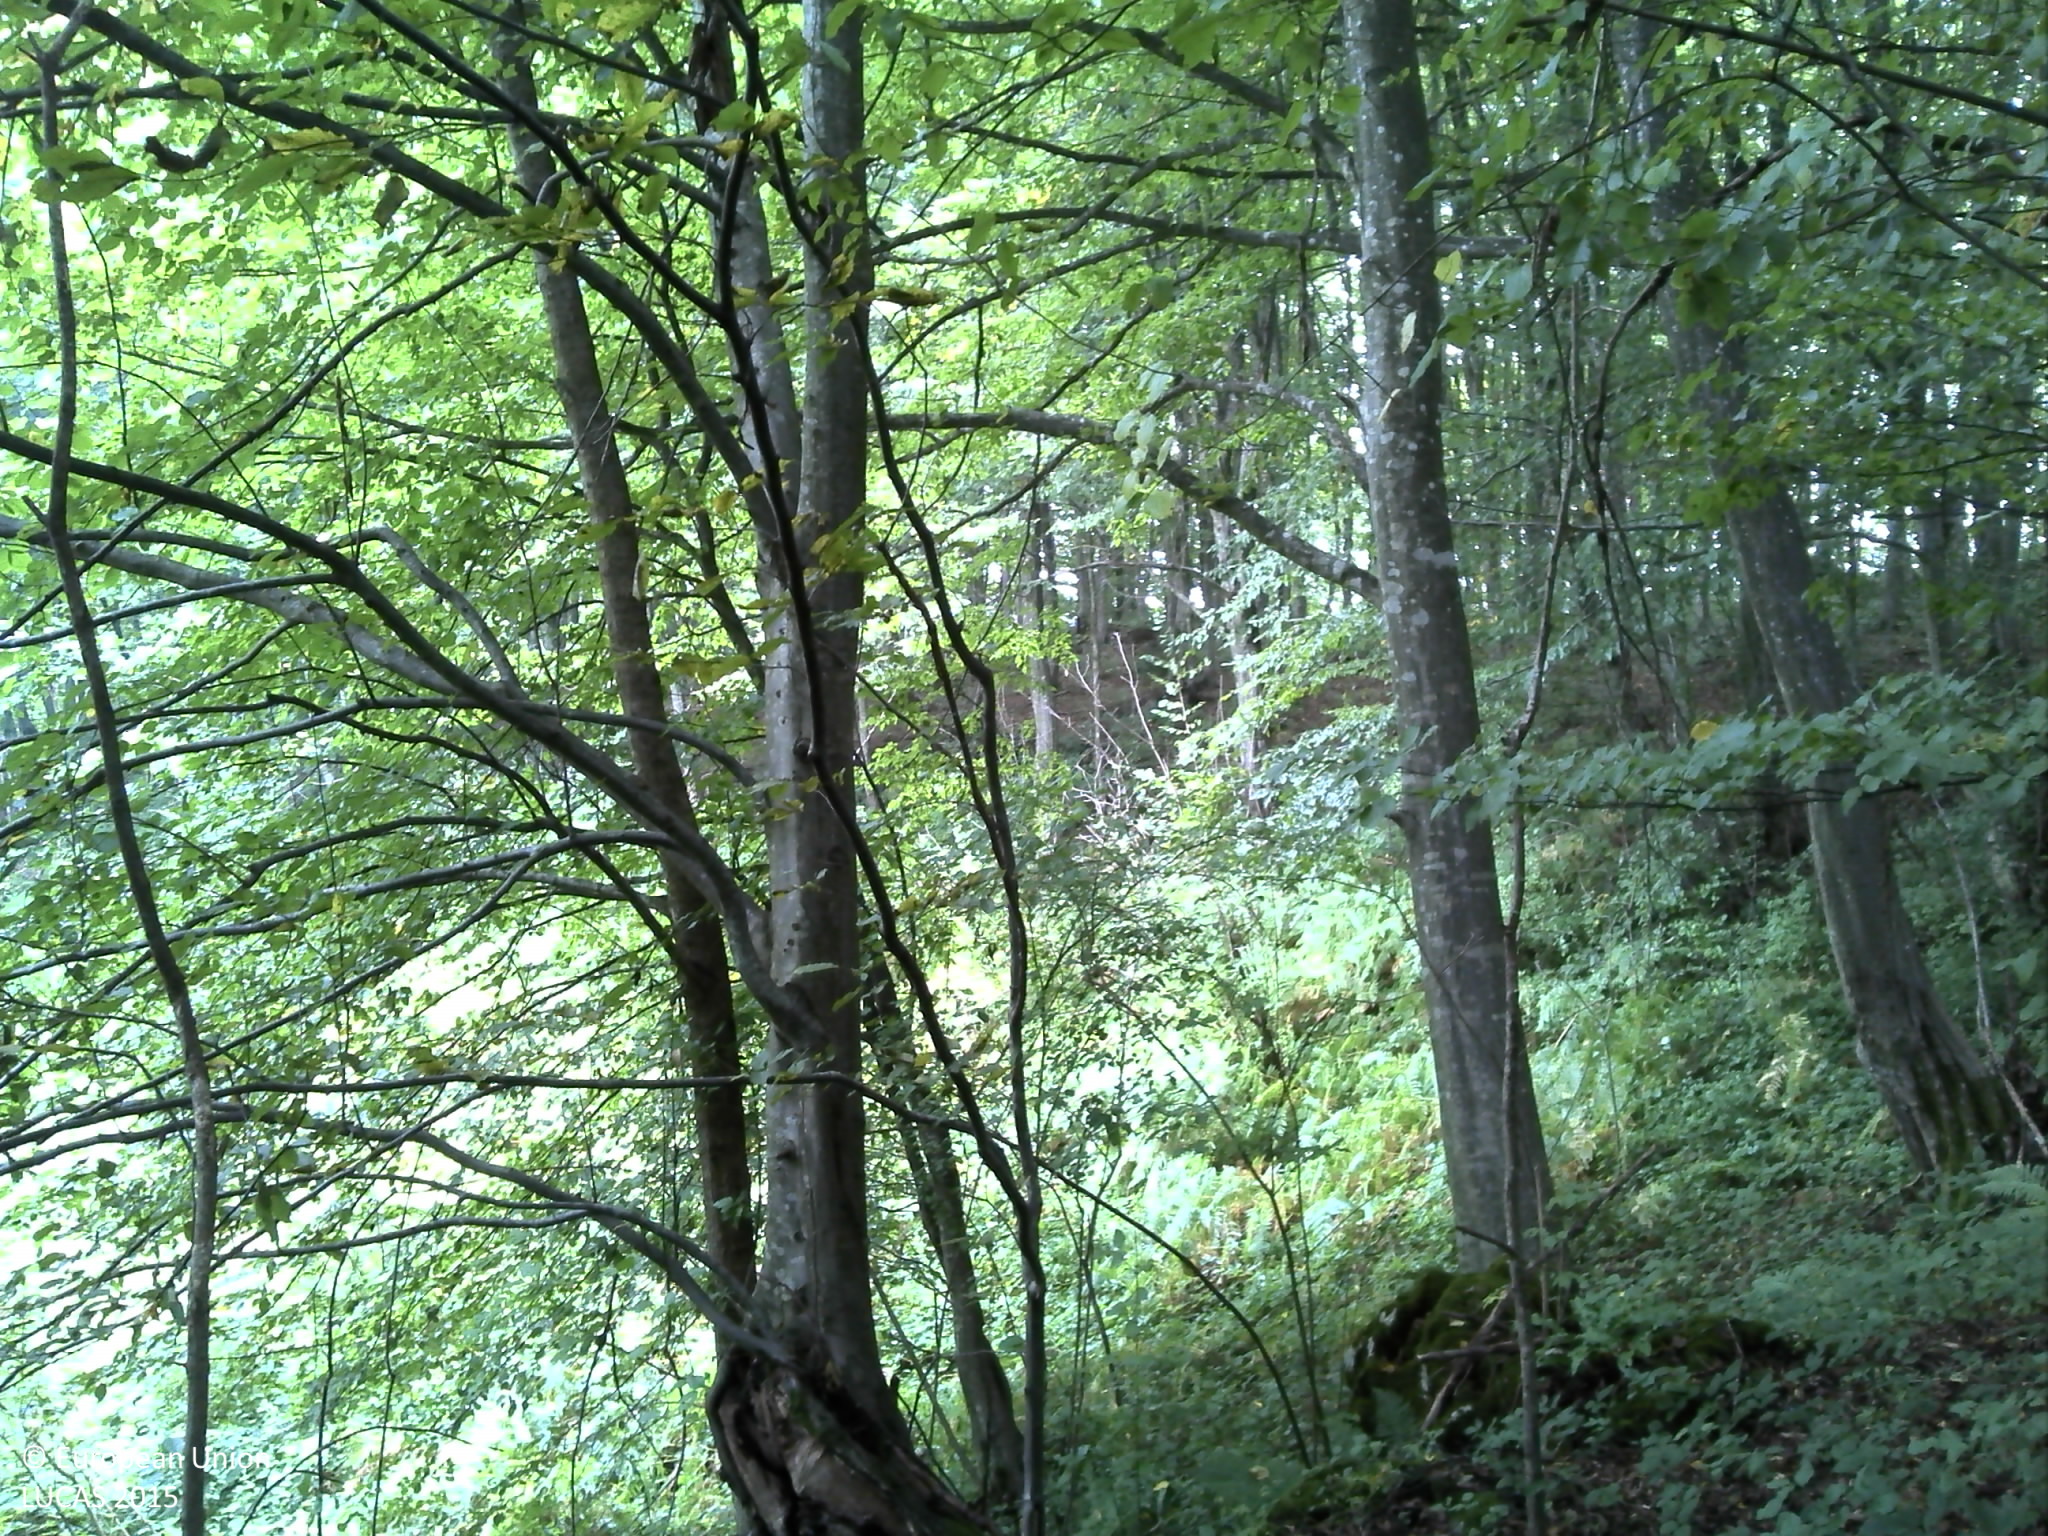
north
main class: Woodland
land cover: Broadleaved woodland
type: beech forest
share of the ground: > 75 %
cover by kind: broadleaved forest trees 100 %
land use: Forestry
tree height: > 5 m
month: August
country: HR
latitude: 45.2439
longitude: 15.6650
